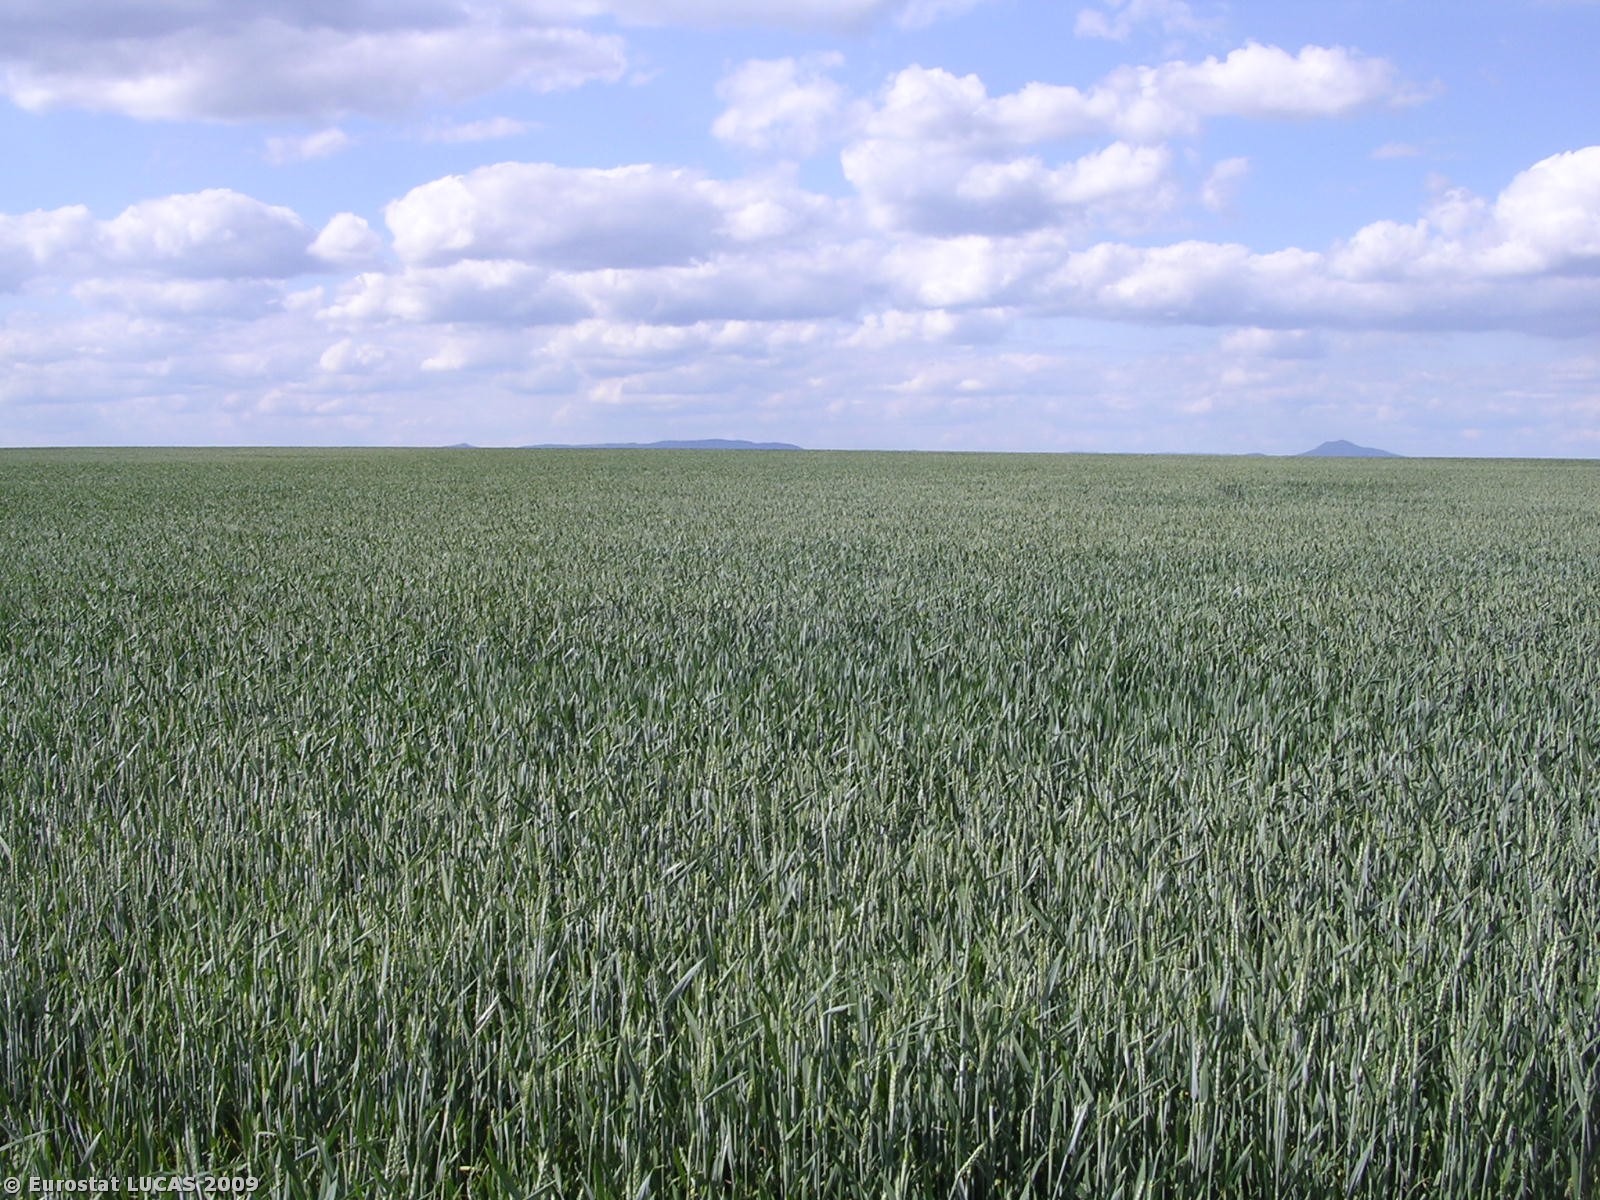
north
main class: Cropland
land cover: Common wheat
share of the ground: > 75 %
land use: Agriculture (excluding fallow land and kitchen gardens)
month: May
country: CZ
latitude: 50.3778
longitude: 14.1776
